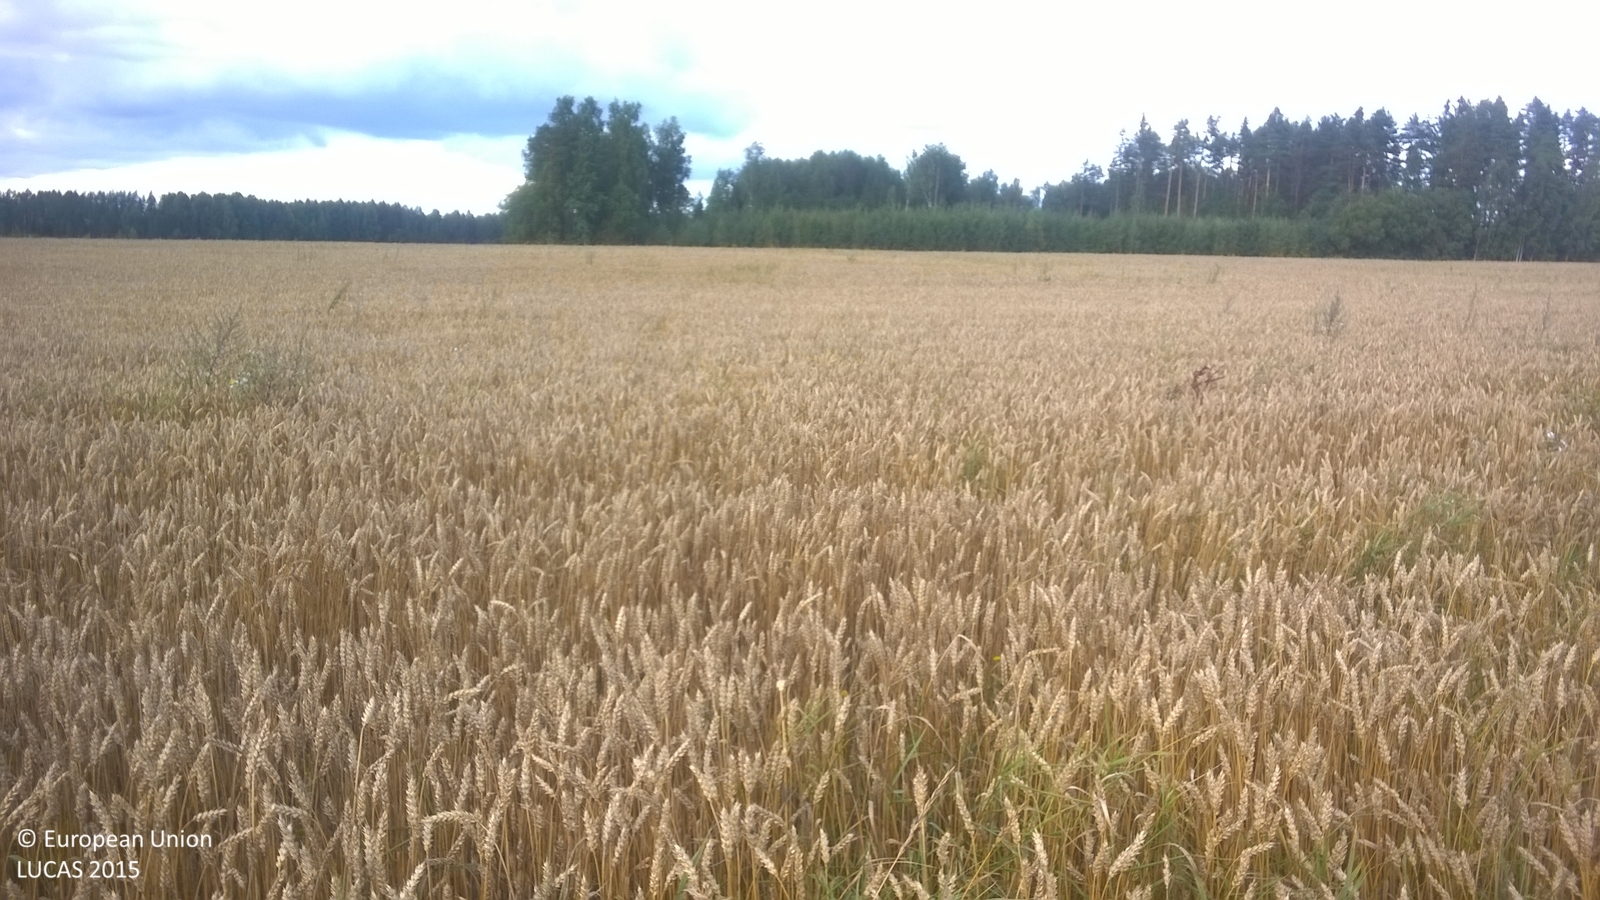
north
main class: Cropland
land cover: Common wheat
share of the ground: > 75 %
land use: Agriculture (excluding fallow land and kitchen gardens)
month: August
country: LV
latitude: 57.3904
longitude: 25.9155
